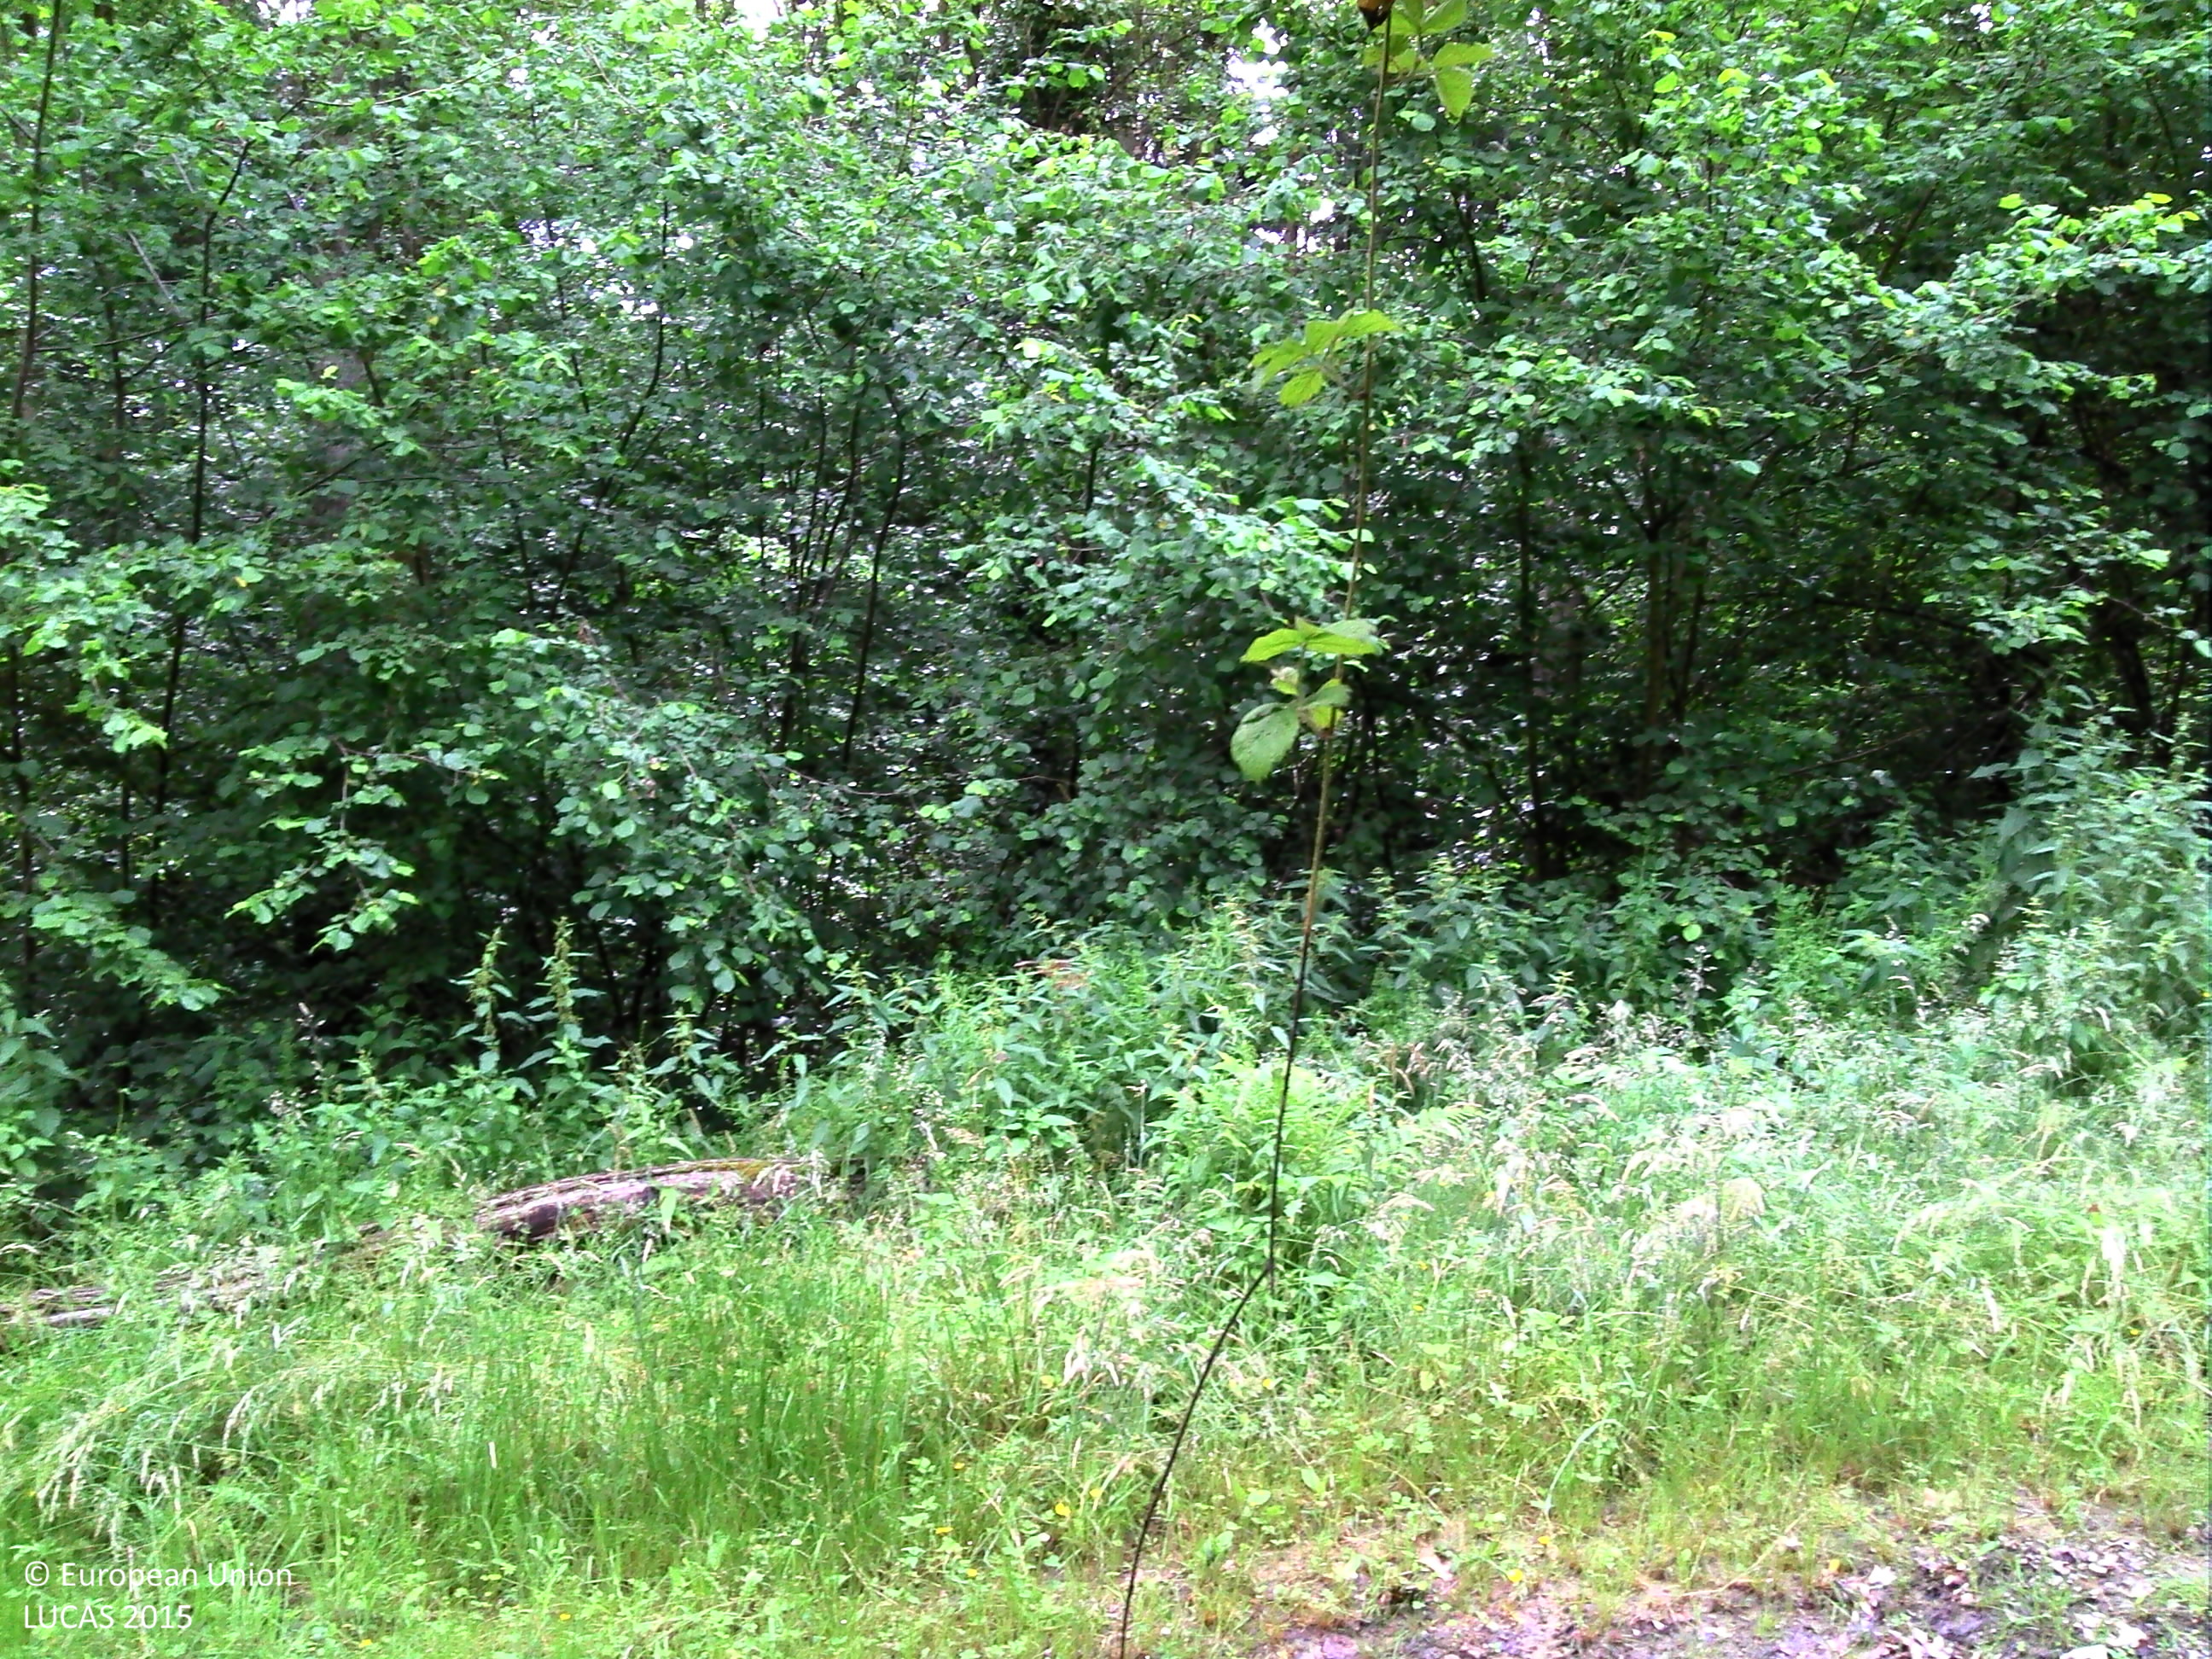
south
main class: Woodland
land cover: Broadleaved woodland
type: acidophilous oak and oak-birch forest
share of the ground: > 75 %
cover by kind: broadleaved forest trees 65 %, herbaceous plants 30 %, coniferous forest trees 5 %
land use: Forestry
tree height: > 5 m
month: June
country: BE
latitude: 50.4580
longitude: 5.5613
